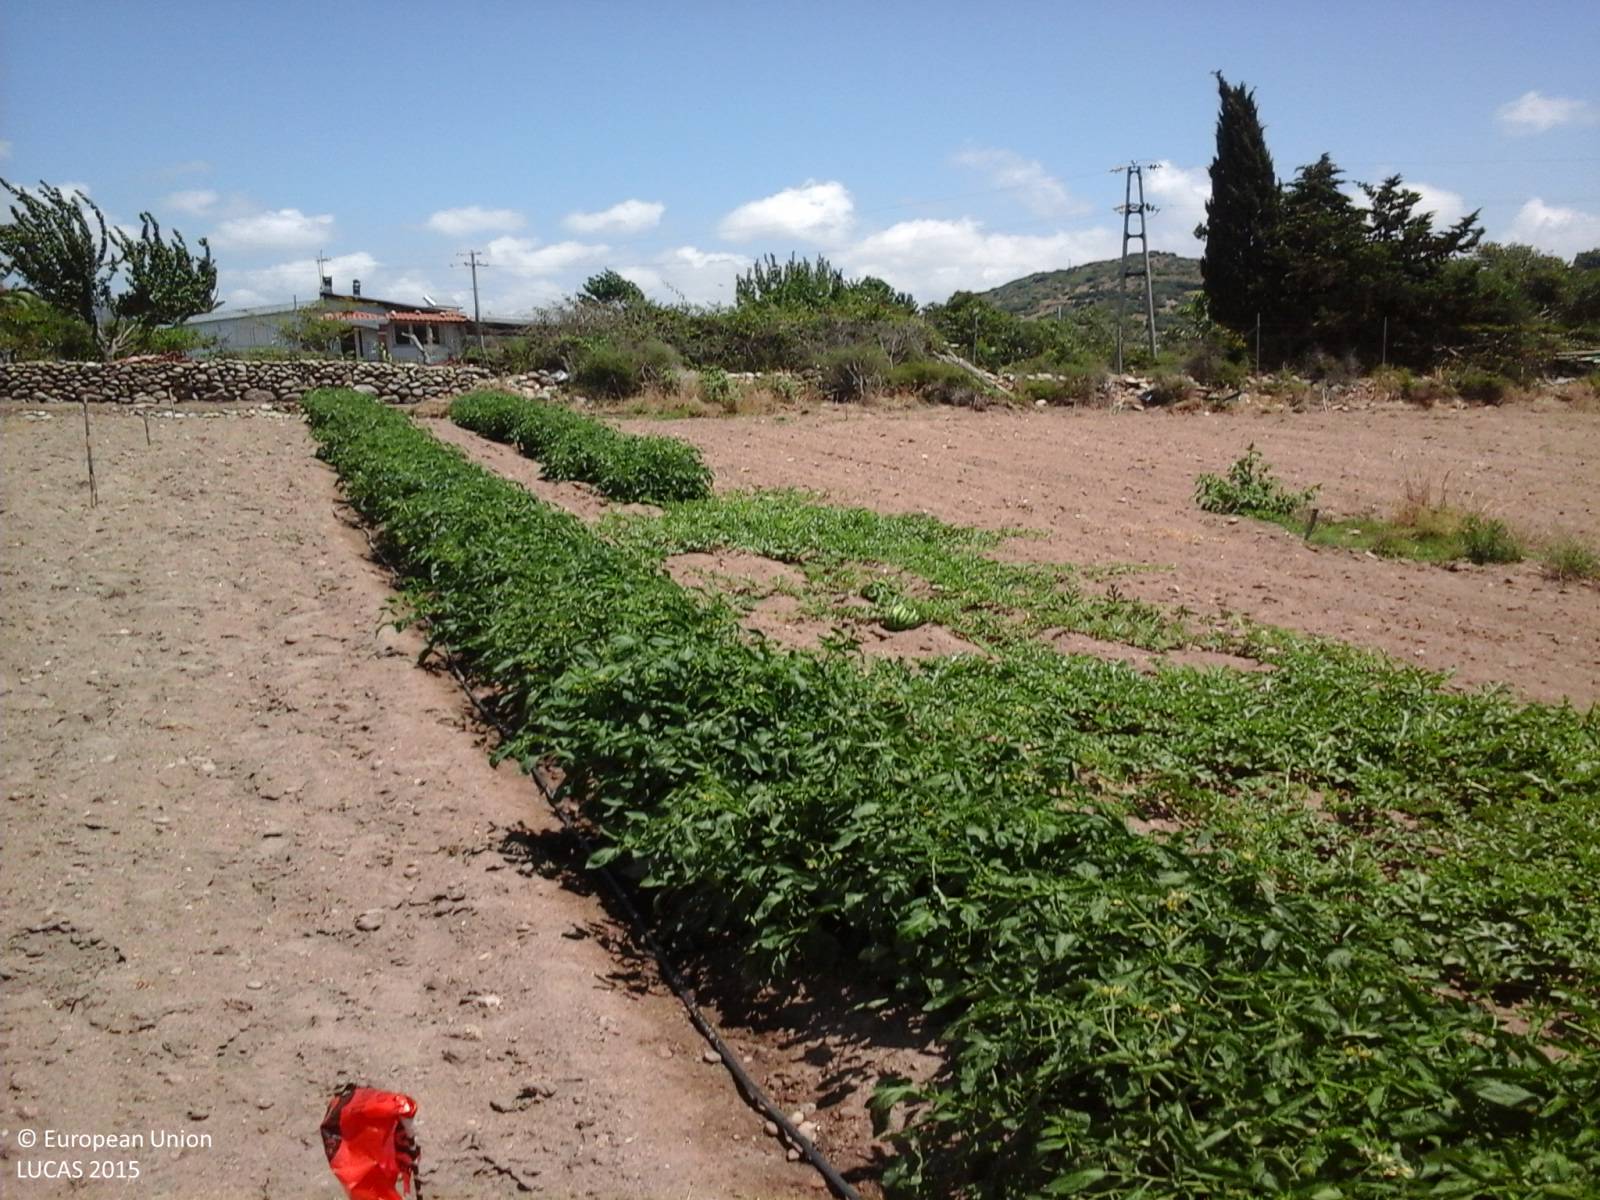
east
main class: Cropland
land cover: Tomatoes
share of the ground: > 75 %
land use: Kitchen garden
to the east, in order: Tomatoes; Other fresh vegetables; Dry stone walls; Fences; Abandoned hedges; Grassland with sparse tree/shrub cover; Pear fruit; Fences; Electric lines; Abandoned hedges; Arable land (only in case pi); Abandoned hedges; Arable land (only in case pi); Paved roads, cycling and walking lanes; Fences; Arable land (only in case pi); Tracks; Arable land (only in case pi)
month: June
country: IT
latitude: 40.4115
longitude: 9.6366
